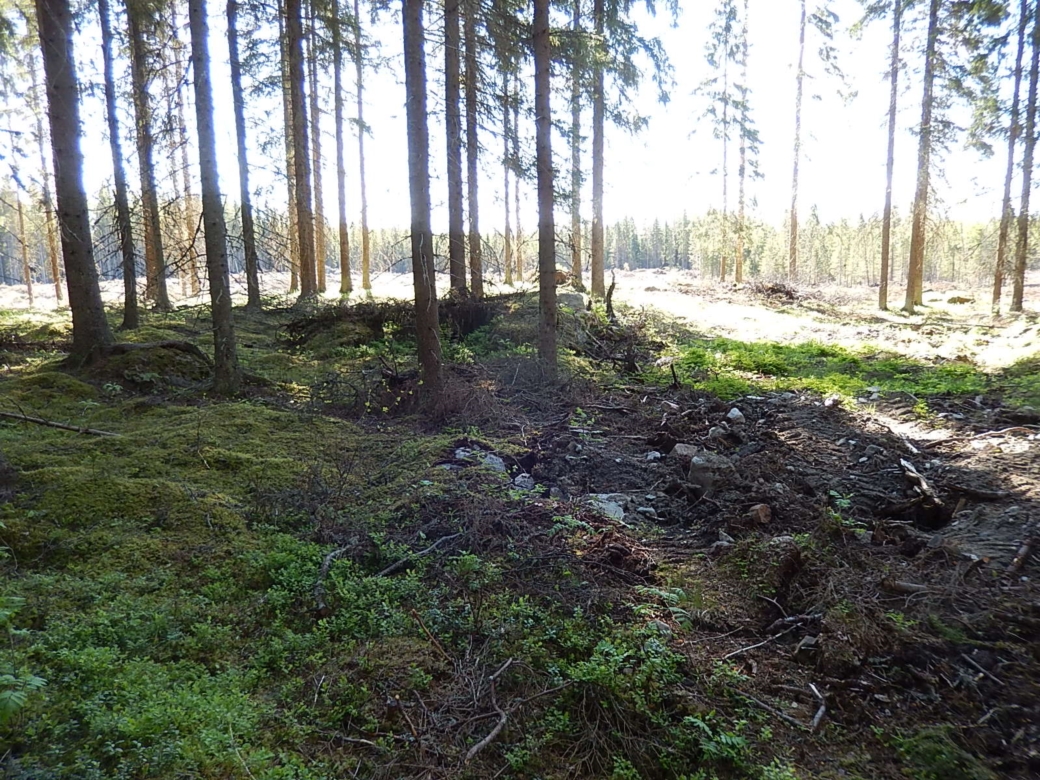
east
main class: Woodland
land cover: Spruce dominated coniferous woodland
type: boreal forest
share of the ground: > 75 %
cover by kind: coniferous forest trees 80 %, shrubs 10 %, lichens and mosses 5 %, unconsolidated bare surface 5 %
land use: Forestry
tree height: > 5 m
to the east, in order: Spruce dominated coniferous woodland; Lichens and moss; Ditches and canals; Lichens and moss; Ditches and canals; Lichens and moss; Ditches and canals; Spruce dominated mixed woodland; Ditches and canals; Spruce dominated mixed woodland
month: June
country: FI
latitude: 62.0455
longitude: 21.6944
